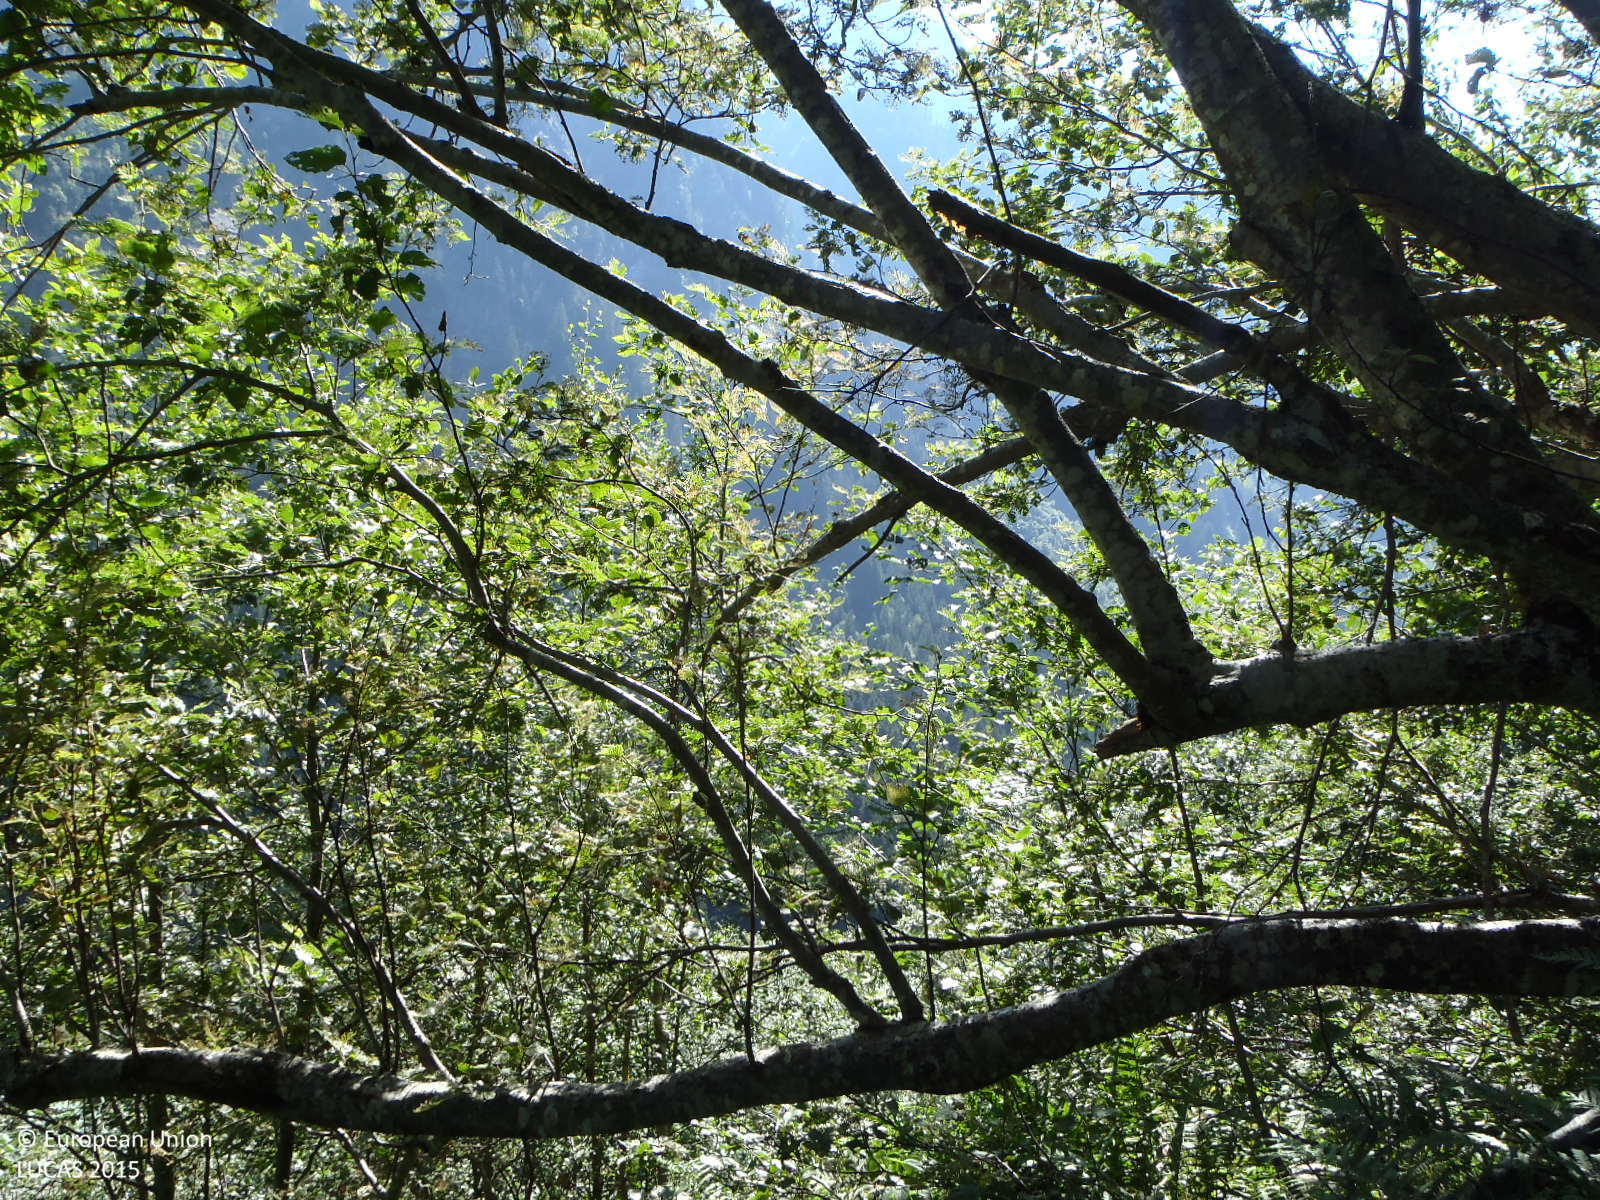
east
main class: Woodland
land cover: Broadleaved woodland
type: mountainous beech forest
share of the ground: > 75 %
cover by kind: broadleaved forest trees 70 %, herbaceous plants 20 %, shrubs 10 %
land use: Forestry
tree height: > 5 m
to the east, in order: Broadleaved woodland; Spruce dominated mixed woodland; Spruce dominated coniferous woodland; Rocks and stones; Spruce dominated mixed woodland; Broadleaved woodland; Spruce dominated coniferous woodland; Tracks; Spruce dominated coniferous woodland
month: July
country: AT
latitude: 47.0921
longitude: 11.8294
